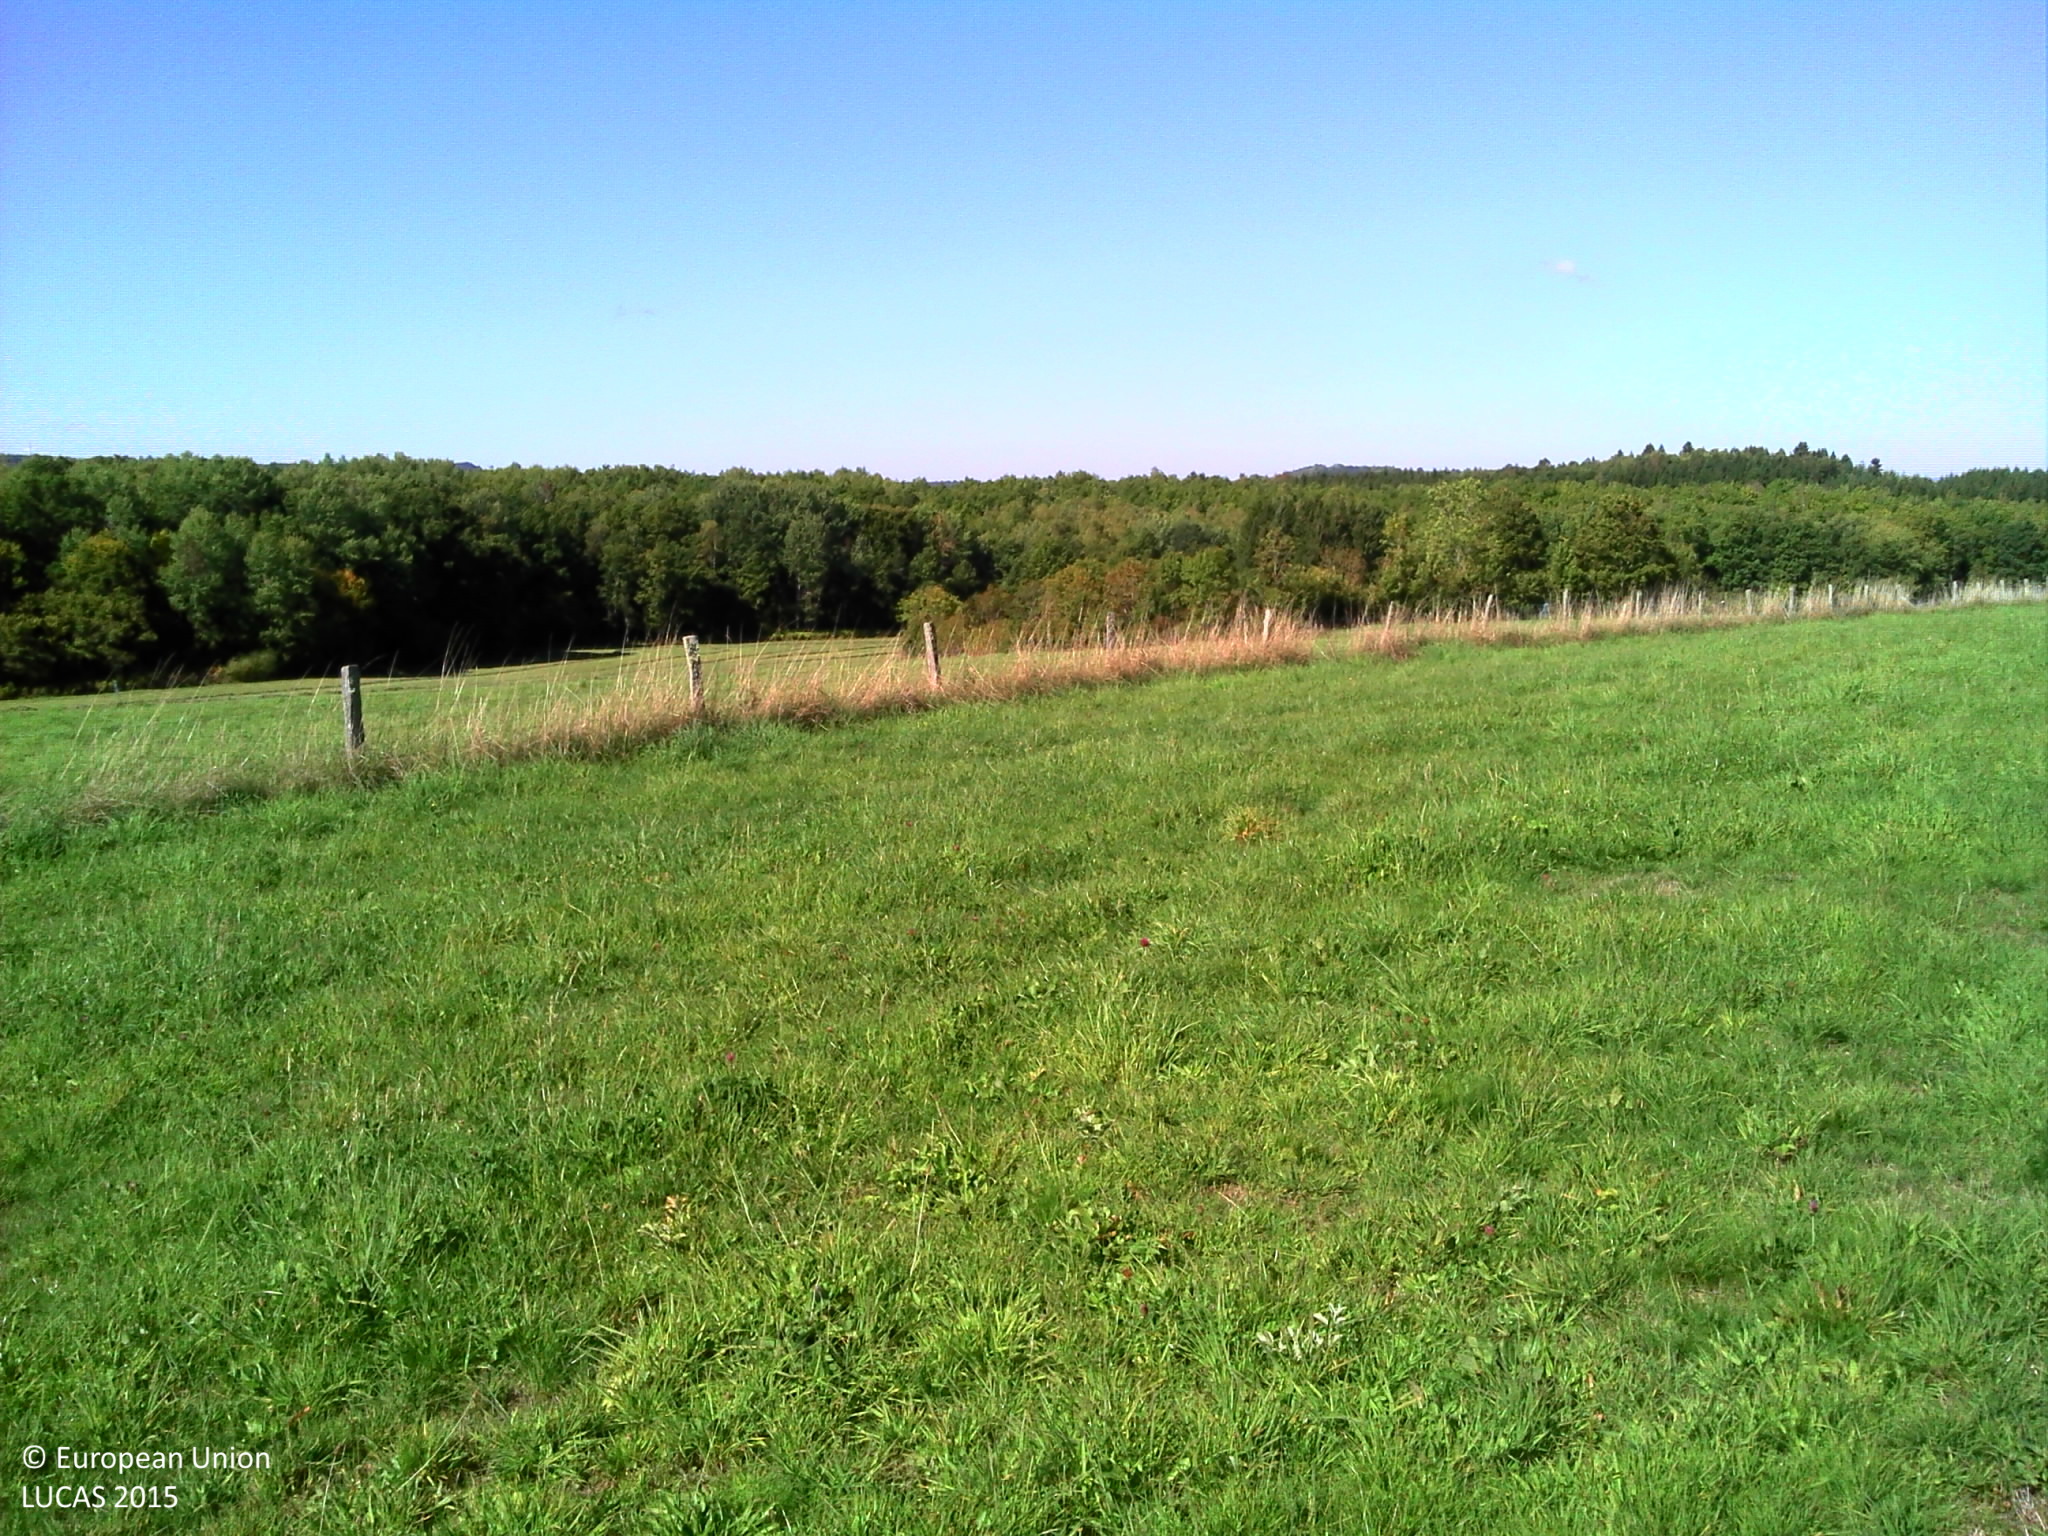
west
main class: Grassland
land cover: Grassland without tree/shrub cover
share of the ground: > 75 %
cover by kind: herbaceous plants 100 %
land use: Agriculture (excluding fallow land and kitchen gardens)
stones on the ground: < 10 %
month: September
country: FR
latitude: 45.8246
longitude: 2.8807
